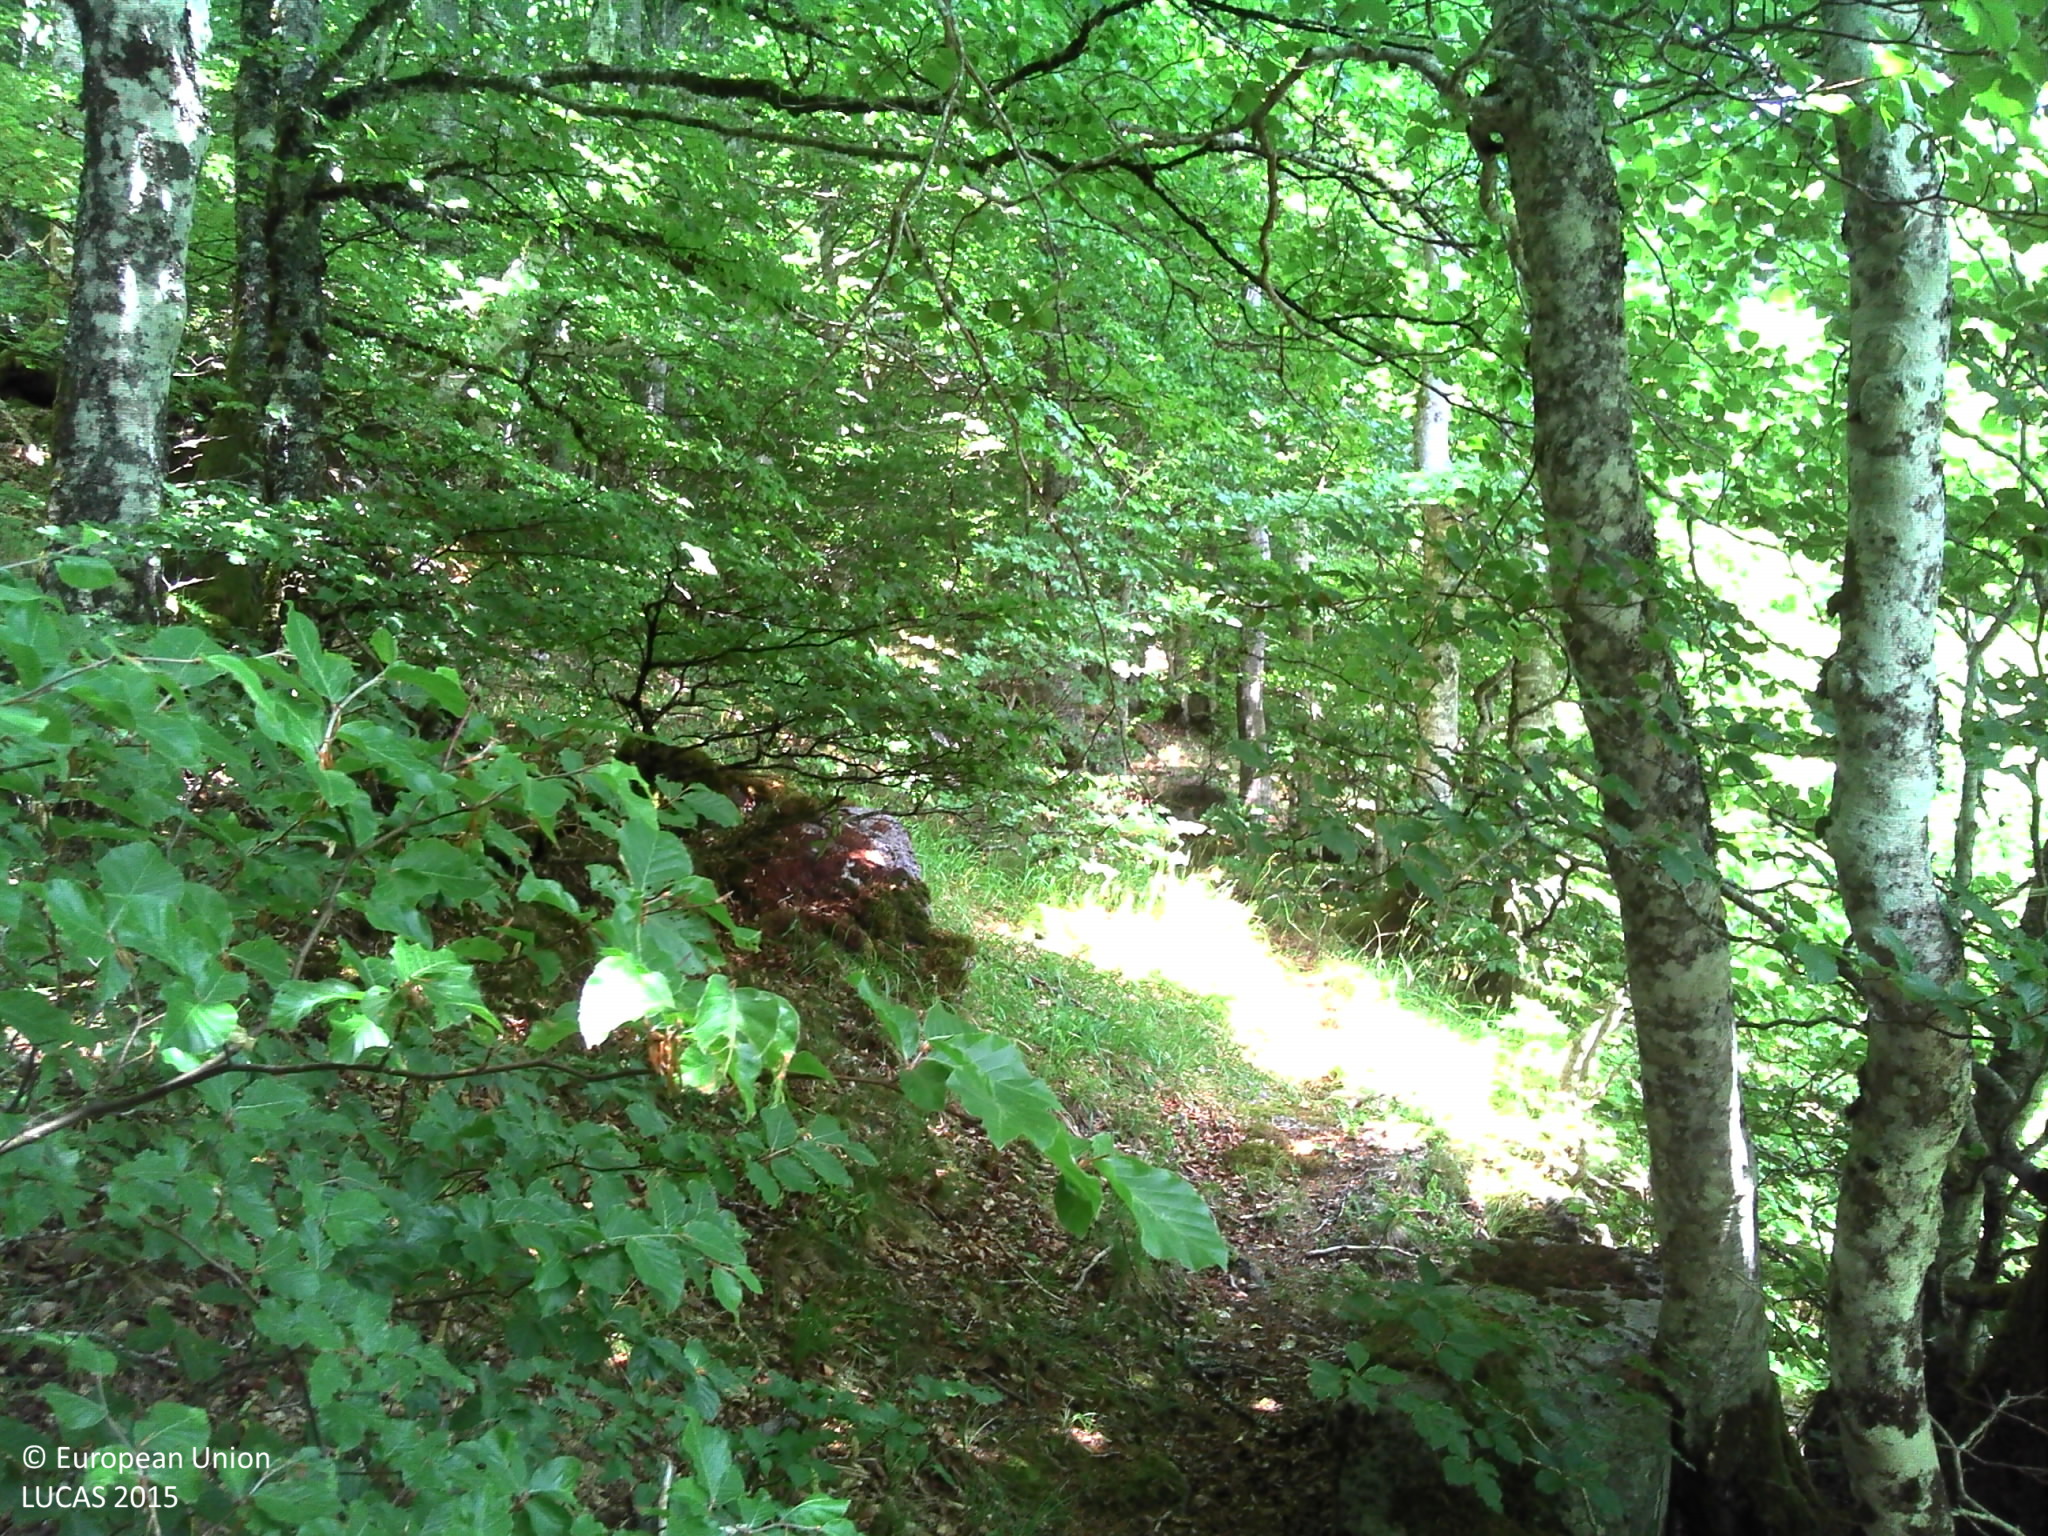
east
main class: Woodland
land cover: Broadleaved woodland
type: beech forest
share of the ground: > 75 %
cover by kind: broadleaved forest trees 80 %, shrubs 15 %, herbaceous plants 5 %
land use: Forestry
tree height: > 5 m
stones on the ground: < 10 %
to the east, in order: Broadleaved woodland
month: July
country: FR
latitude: 44.6521
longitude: 2.9292
